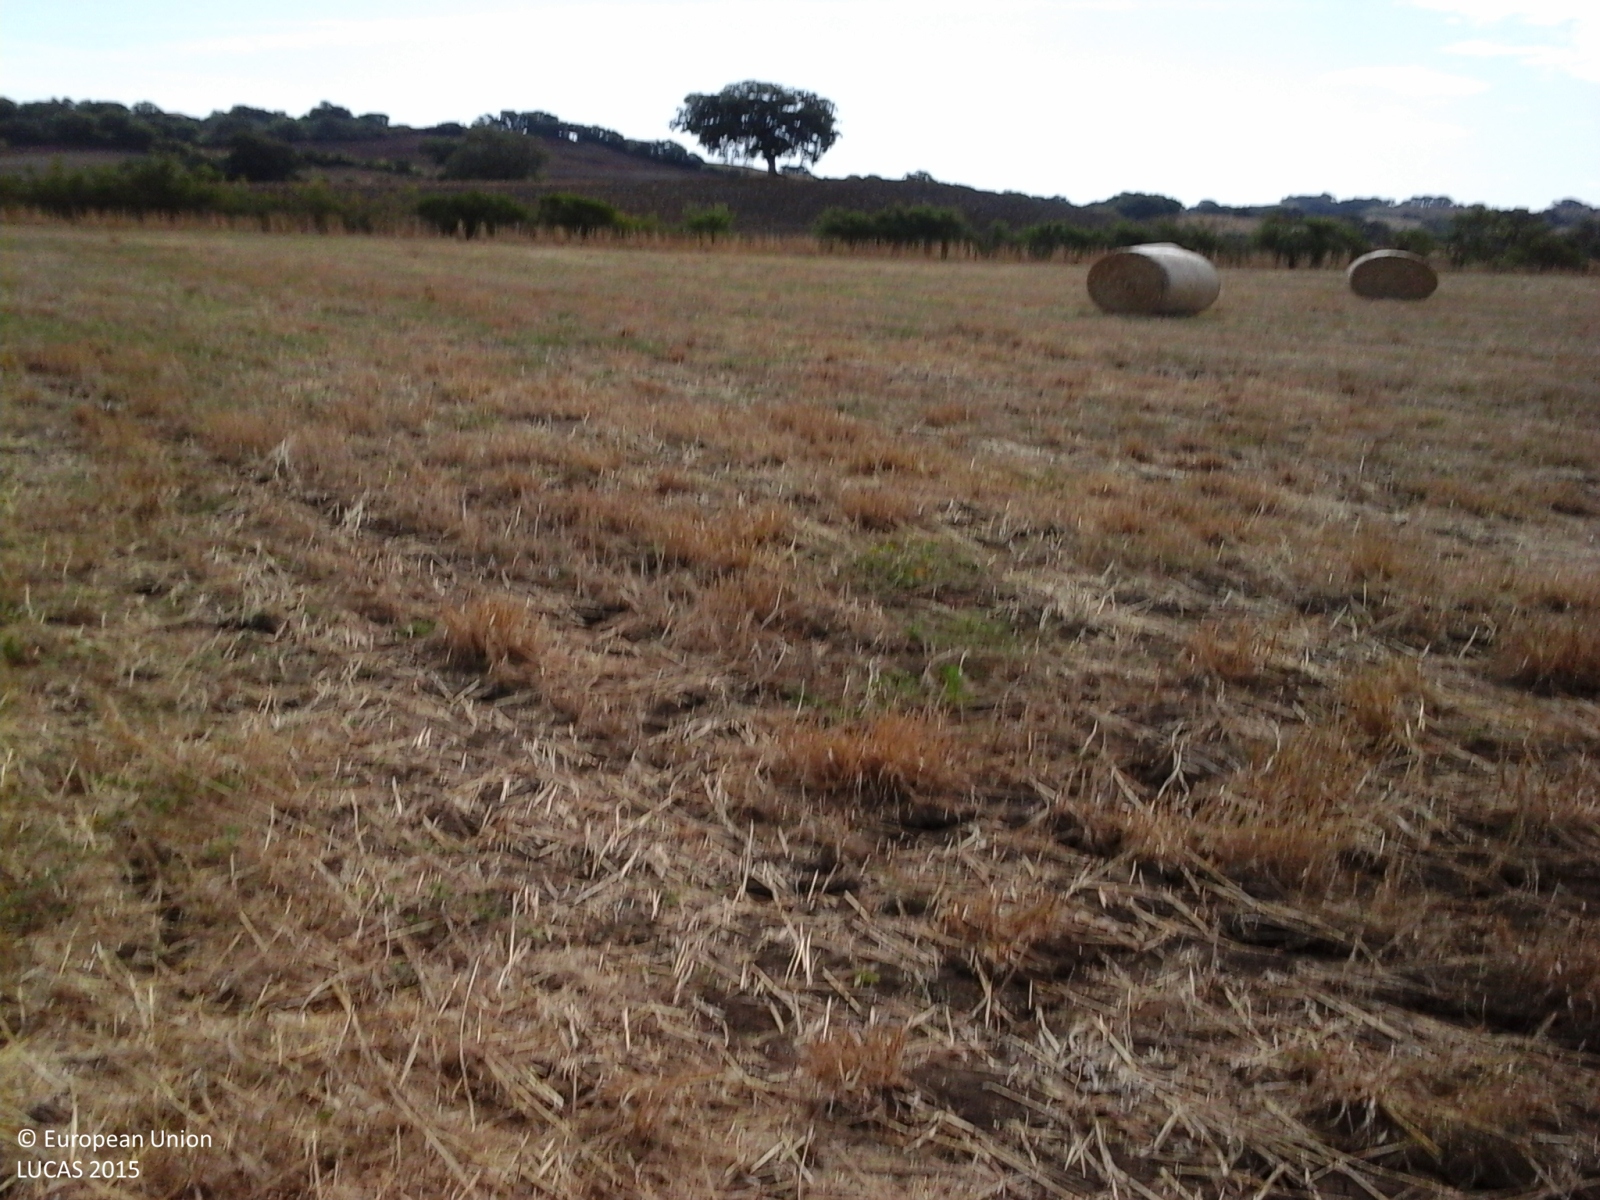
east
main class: Cropland
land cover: Durum wheat
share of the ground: > 75 %
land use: Agriculture (excluding fallow land and kitchen gardens)
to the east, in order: Durum wheat; Grass margins; Tracks; Abandoned hedges; Fences; Temporary grasslands
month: August
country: IT
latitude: 42.5715
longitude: 11.4448
